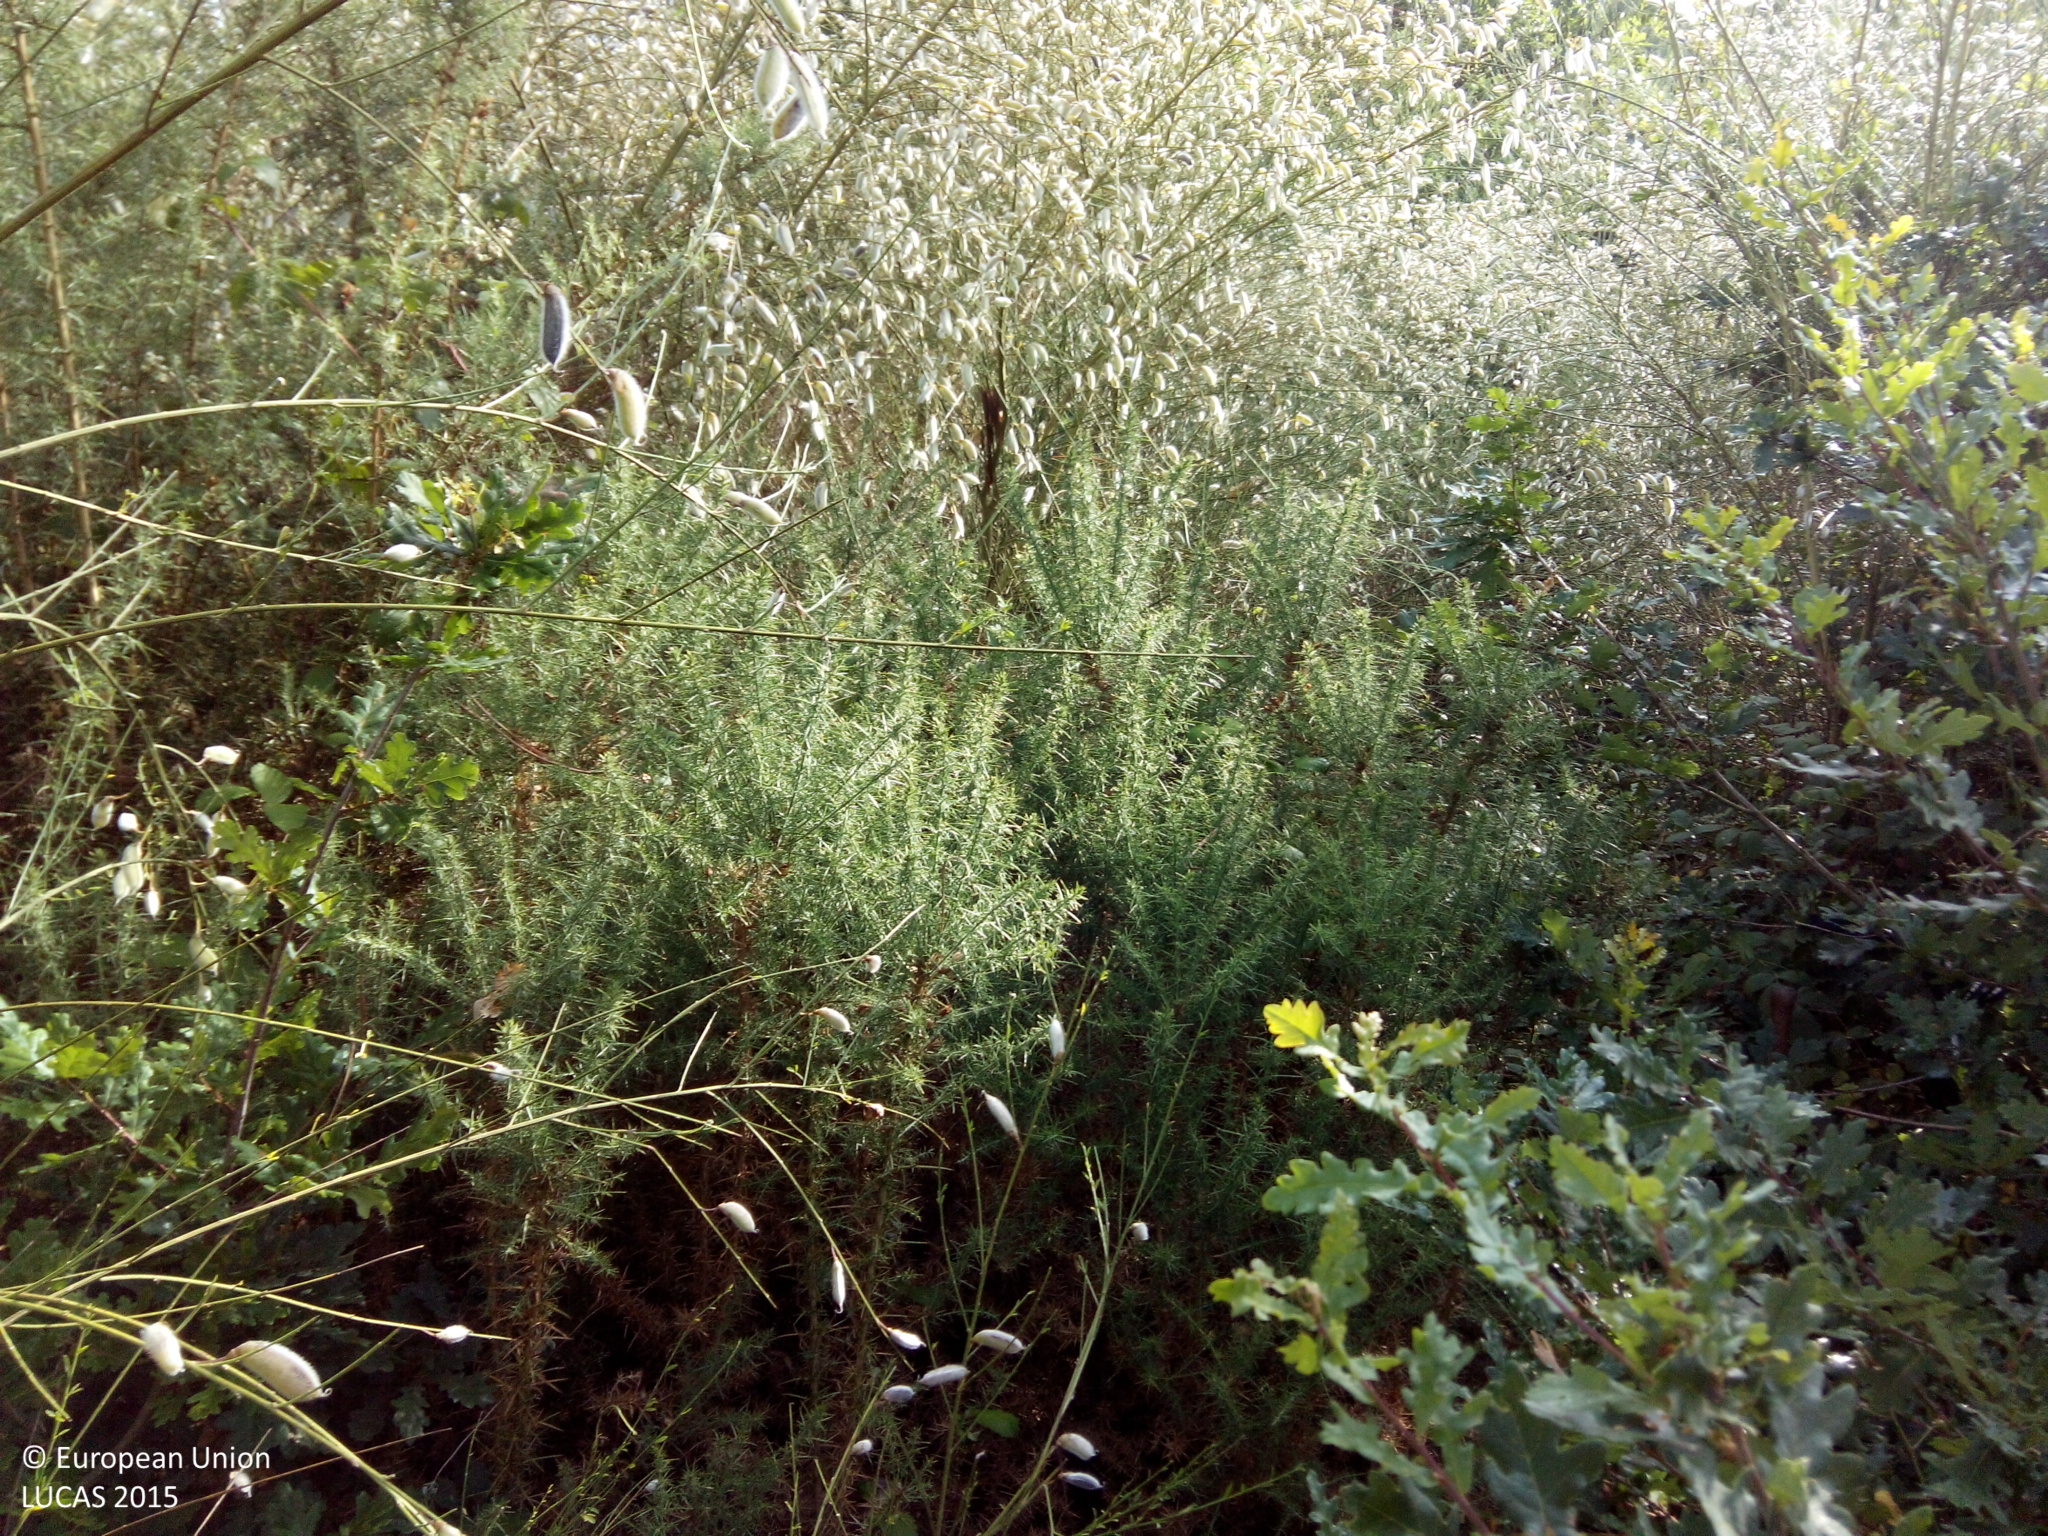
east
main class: Woodland
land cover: Broadleaved woodland
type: acidophilous oak and oak-birch forest
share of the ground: > 75 %
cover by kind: broadleaved forest trees 80 %, shrubs 20 %
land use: Forestry
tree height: > 5 m
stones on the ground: < 10 %
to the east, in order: Broadleaved woodland; Shrubland without tree cover; Rivers and streams; Spontaneously vegetated surfaces; Dry stone walls; Shrubland with sparse tree cover; Tracks; Shrubland without tree cover; Grassland without tree/shrub cover; Shrubland with sparse tree cover; Grassland without tree/shrub cover; Shrubland with sparse tree cover
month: July
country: ES
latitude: 42.8150
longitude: -8.0046
